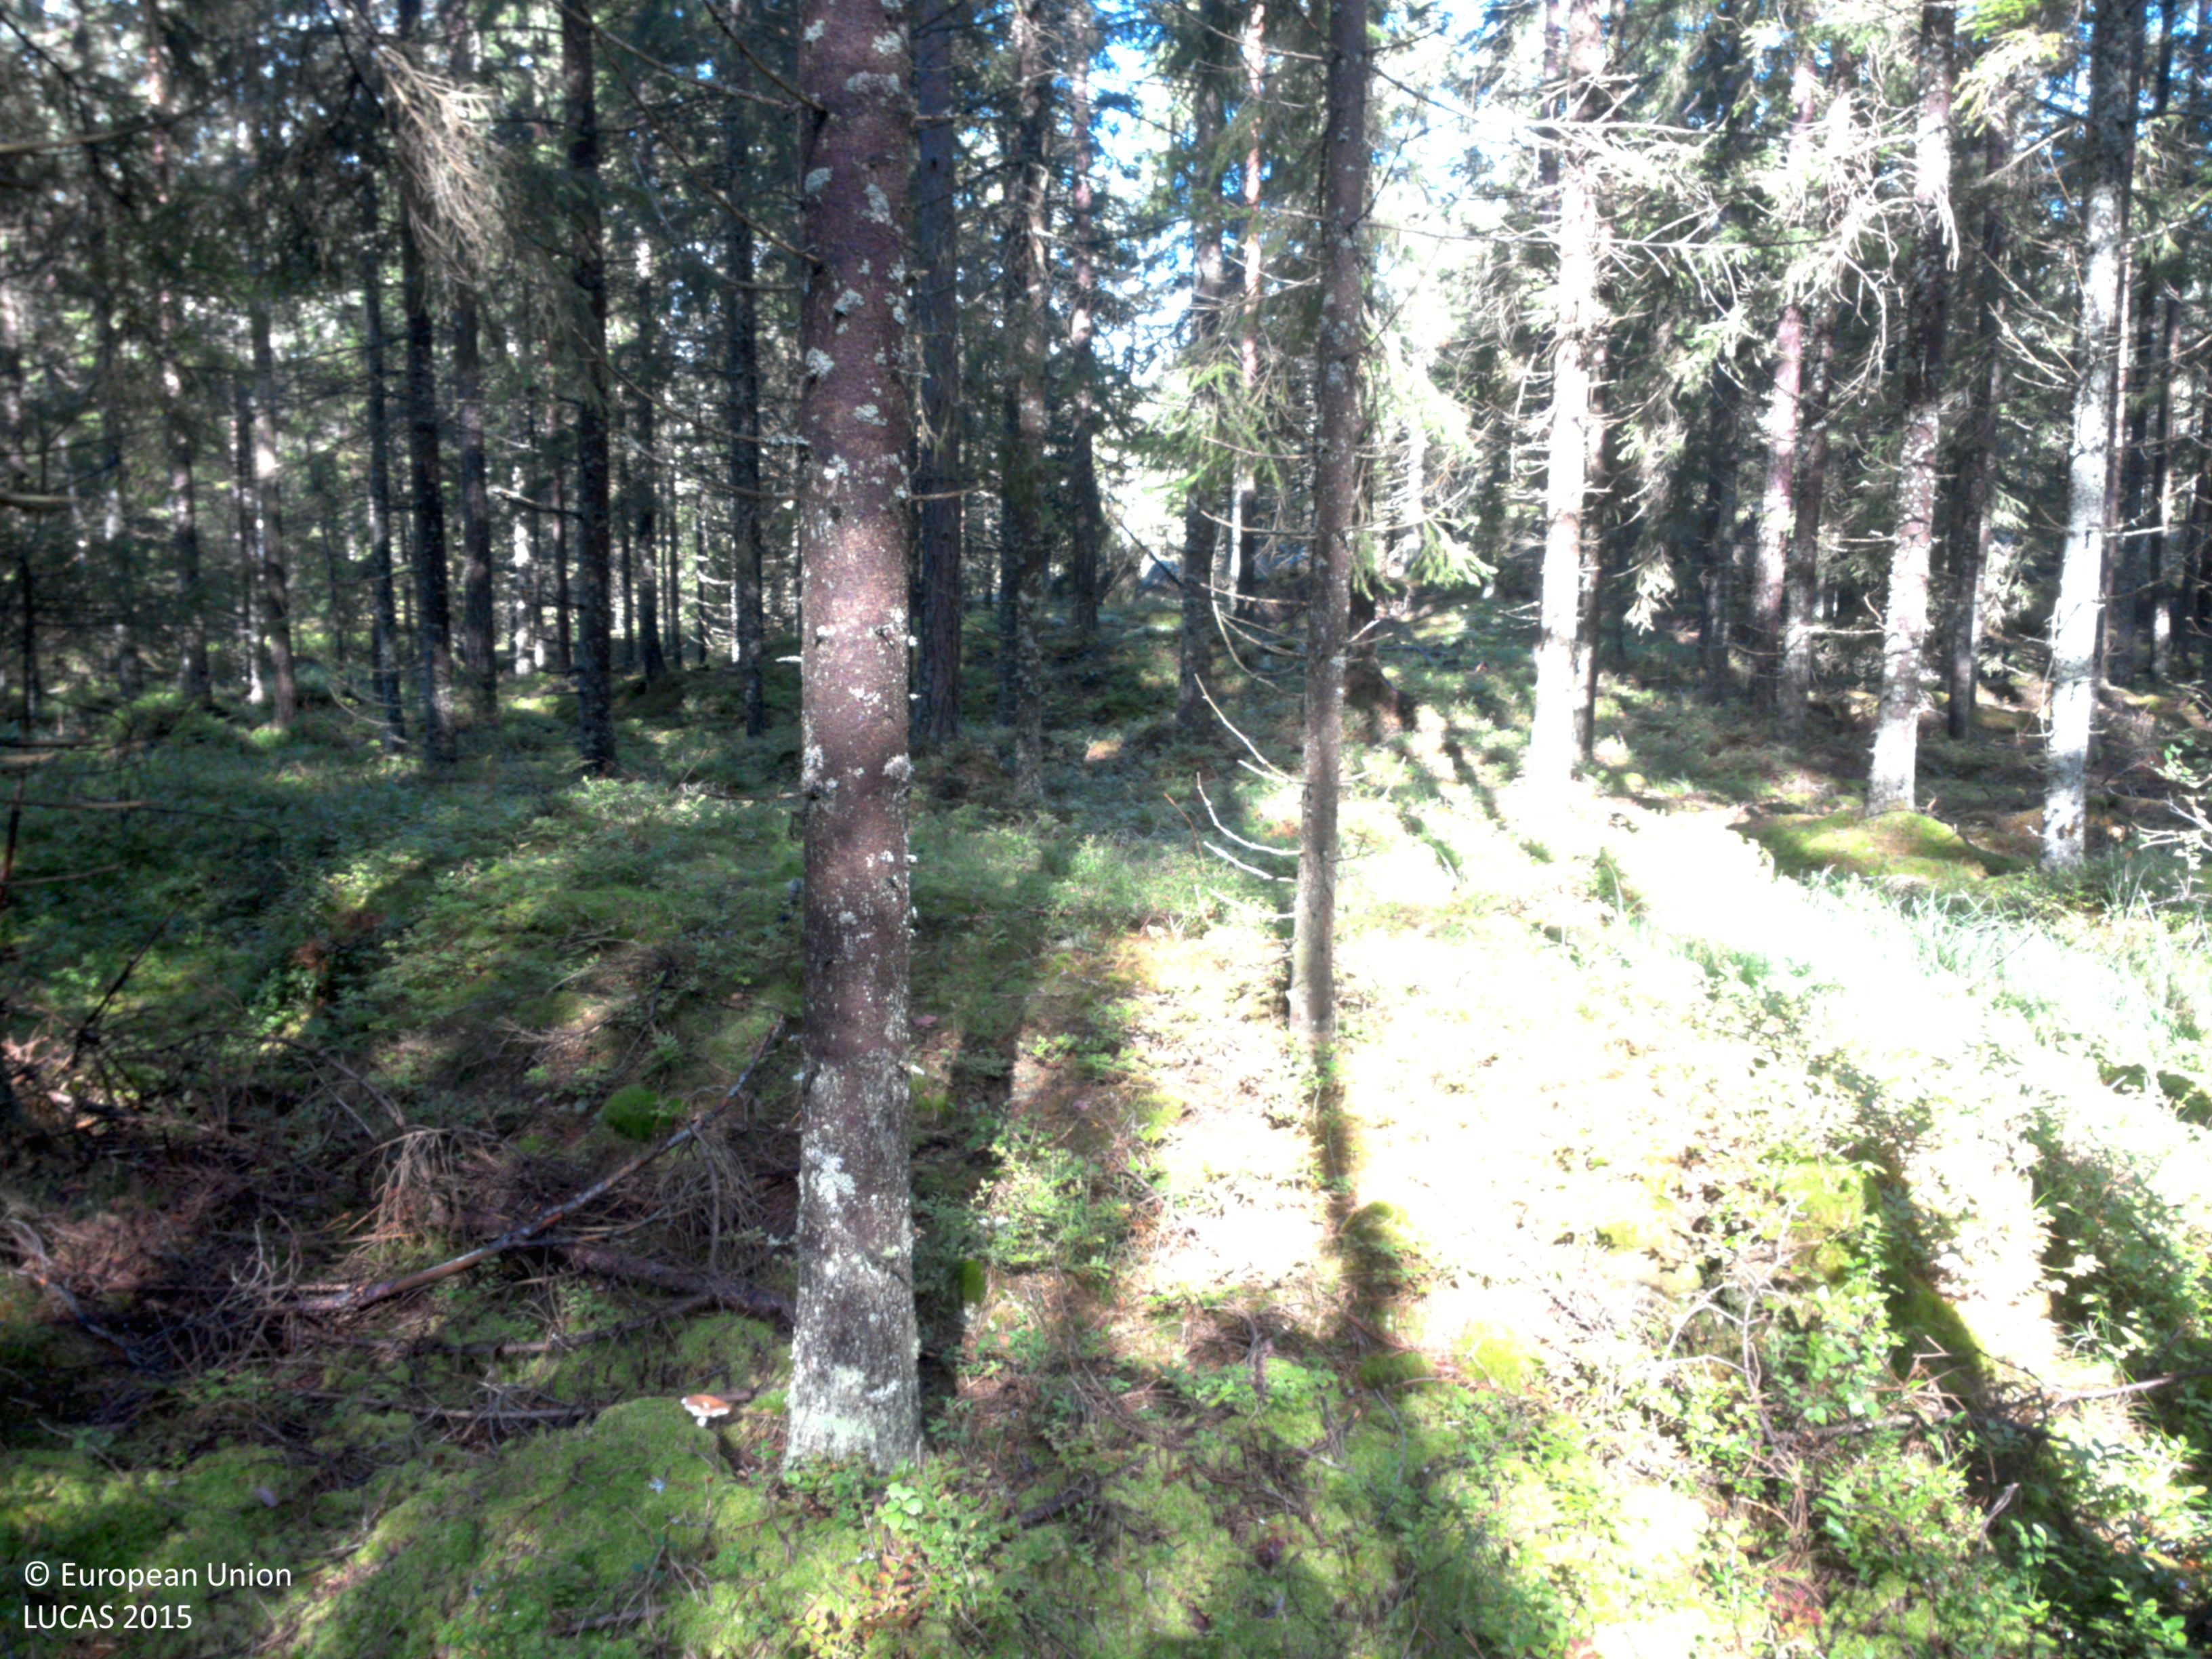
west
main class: Woodland
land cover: Spruce dominated coniferous woodland
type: boreal forest
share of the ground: 50 - 75 %
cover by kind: coniferous forest trees 60 %, lichens and mosses 25 %, shrubs 15 %
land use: Forestry
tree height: > 5 m
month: August
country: SE
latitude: 58.3089
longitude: 12.2314
